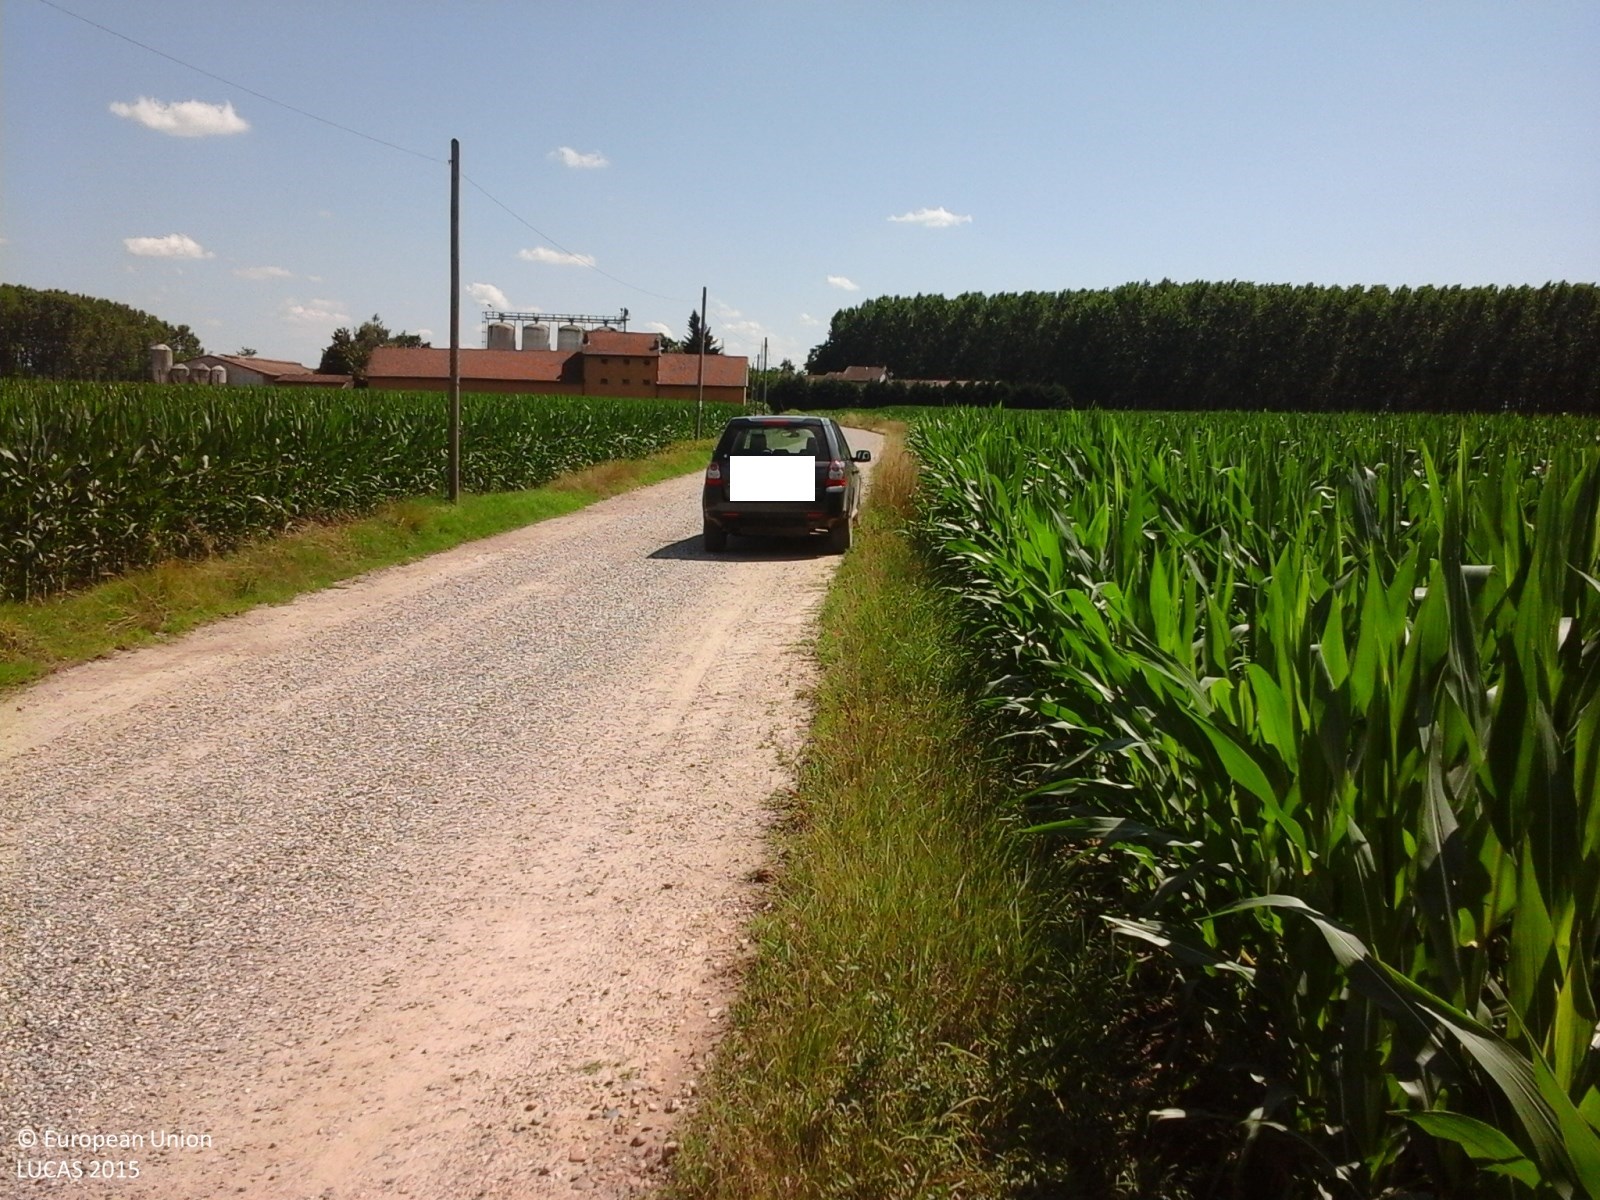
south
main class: Cropland
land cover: Maize
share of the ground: > 75 %
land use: Agriculture (excluding fallow land and kitchen gardens)
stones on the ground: 10 - 25 %
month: June
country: IT
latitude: 44.9572
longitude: 7.7350
